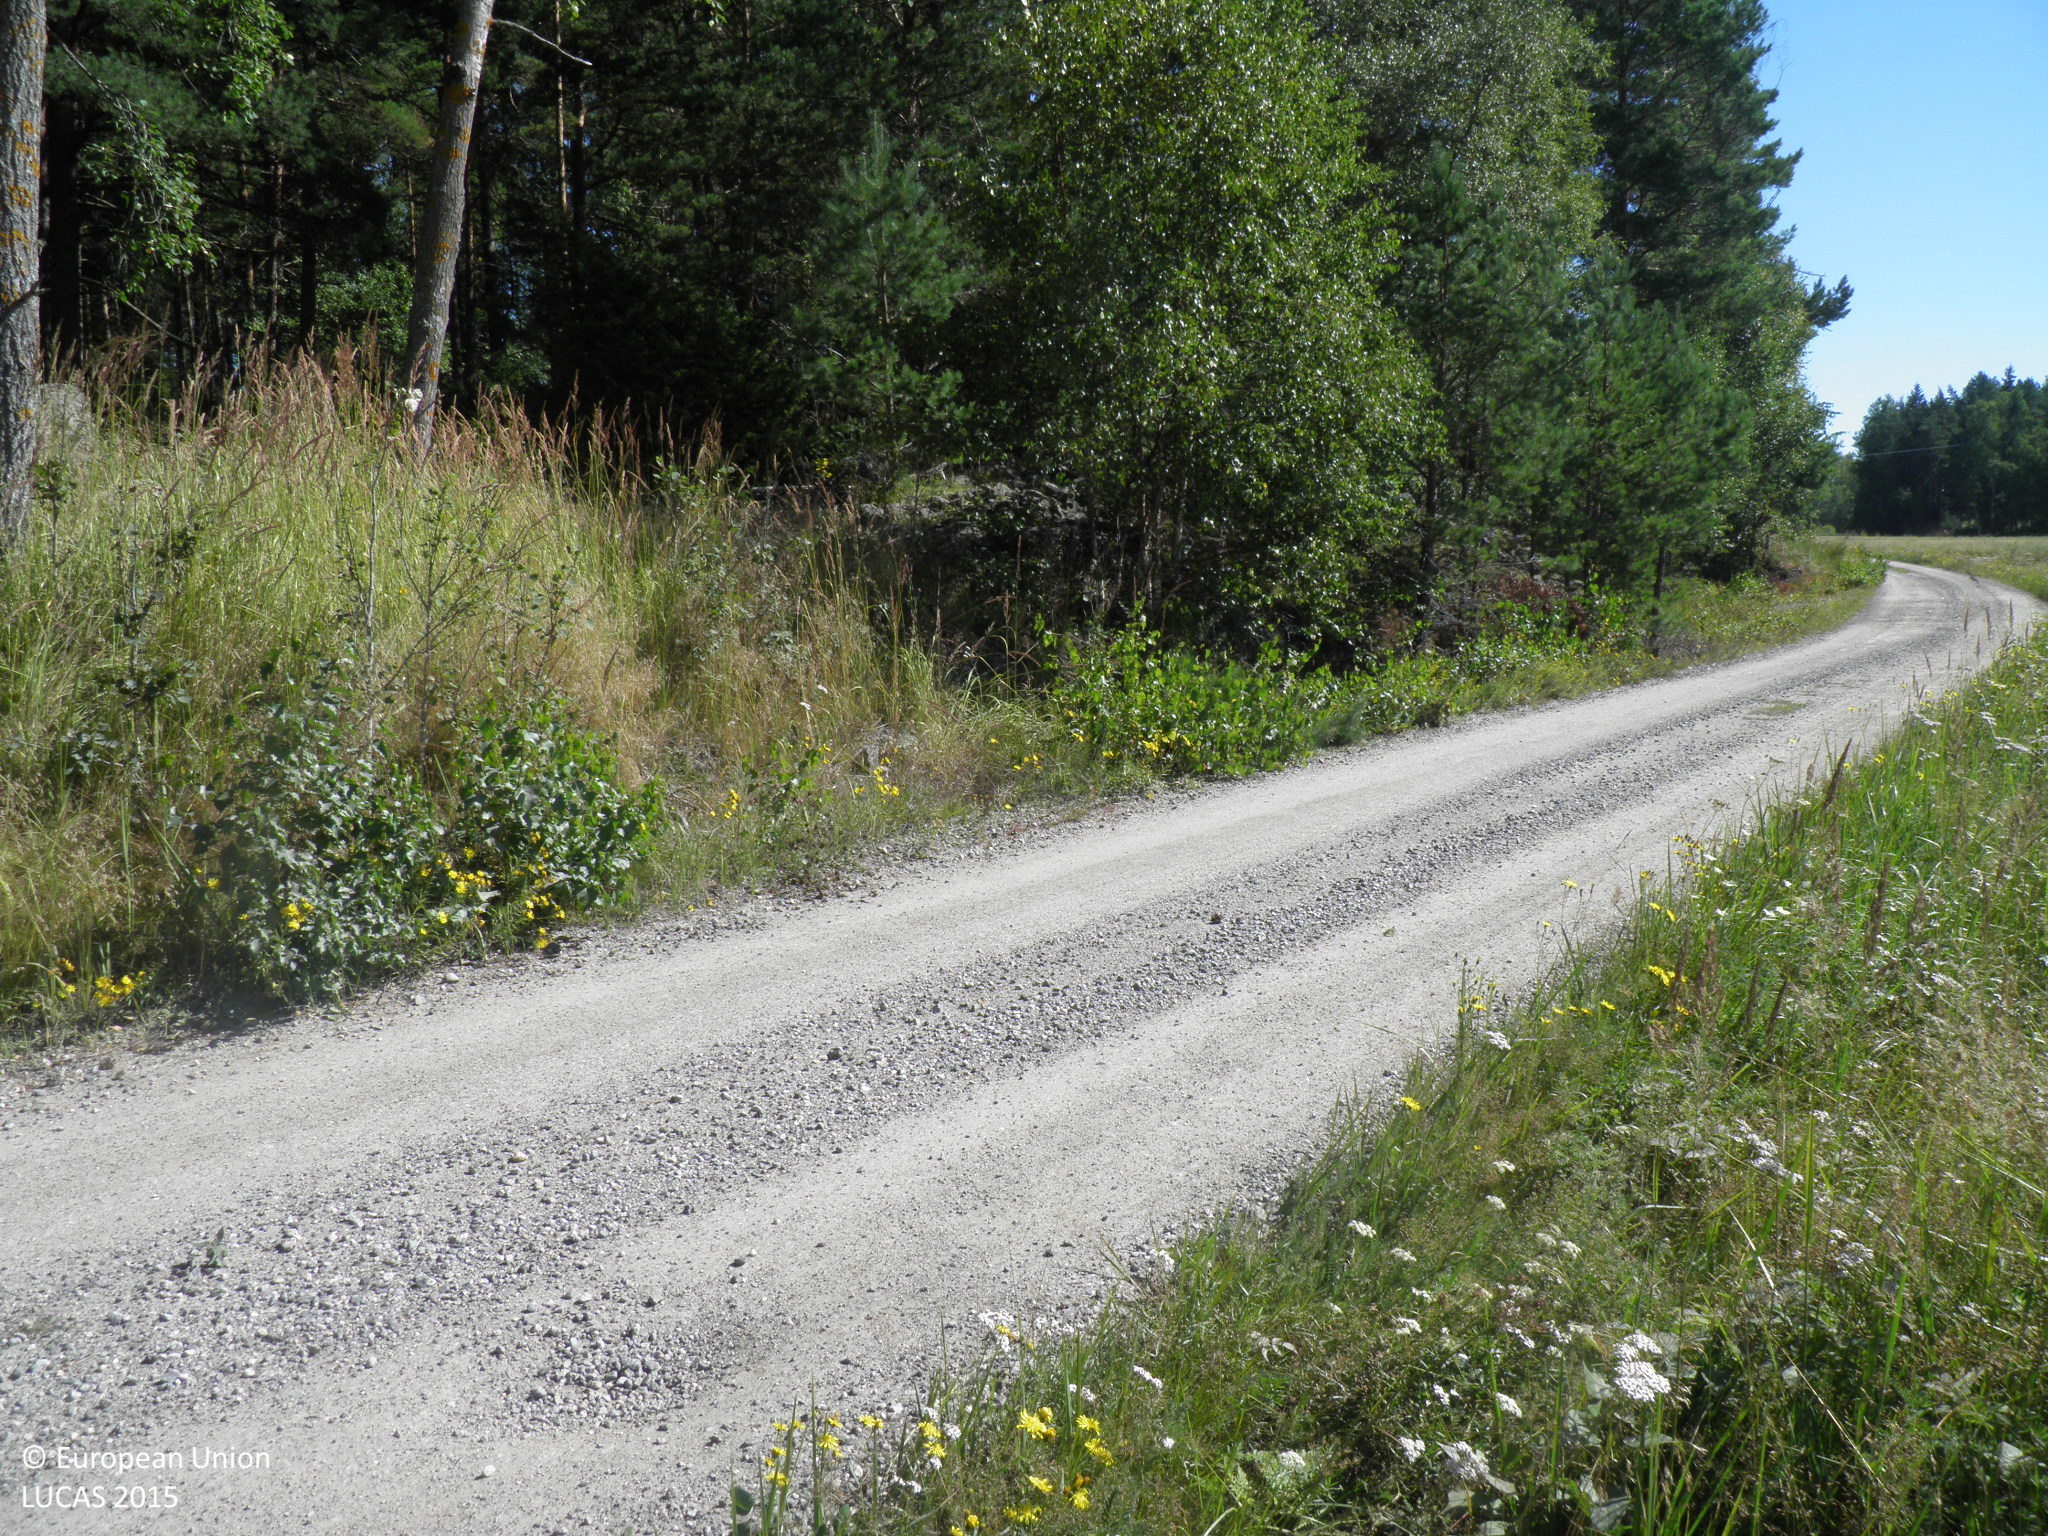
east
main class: Cropland
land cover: Oats
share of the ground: > 75 %
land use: Agriculture (excluding fallow land and kitchen gardens)
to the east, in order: Oats; Ditches and canals; Grass margins; Paved roads, cycling and walking lanes; Grass margins; Pine dominated mixed woodland; Tracks; Pine dominated mixed woodland; Ditches and canals; Spruce dominated coniferous woodland; Tracks; Ditches and canals; Pine dominated mixed woodland
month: August
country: FI
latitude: 60.9816
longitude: 21.3060
